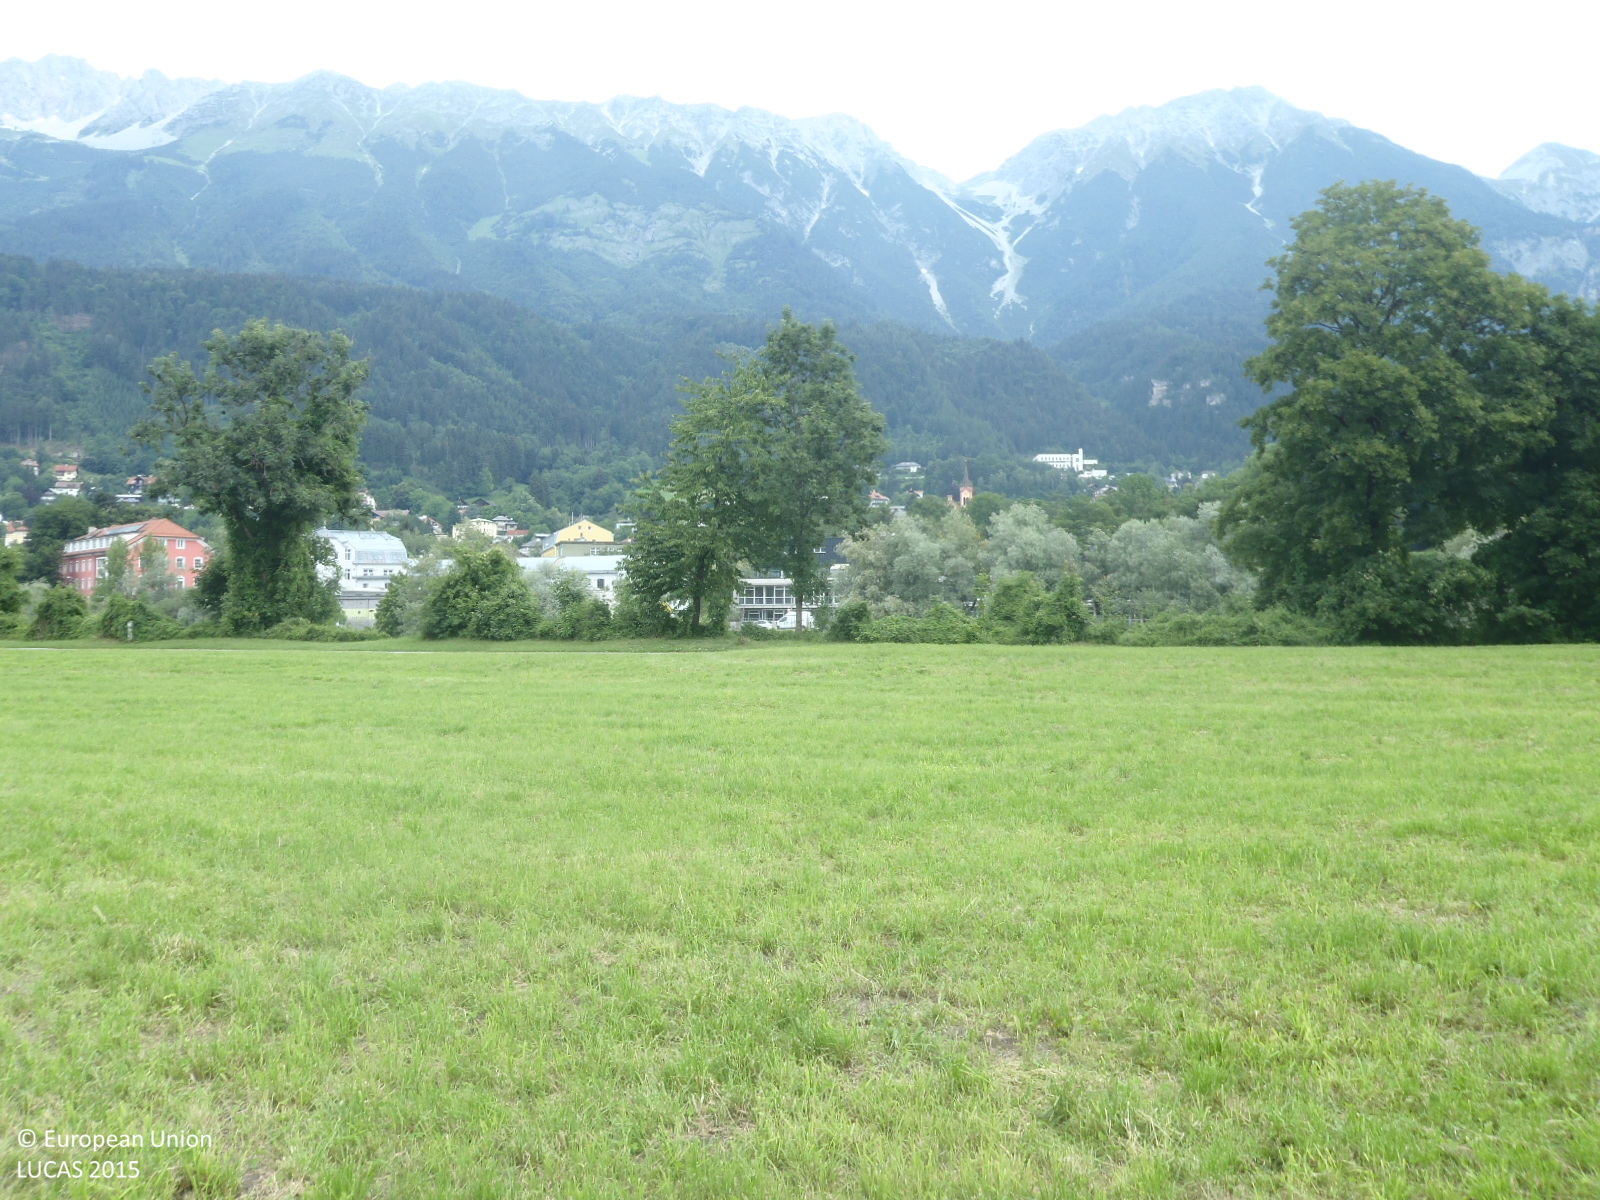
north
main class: Grassland
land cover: Grassland without tree/shrub cover
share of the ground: > 75 %
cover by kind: herbaceous plants 100 %
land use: Agriculture (excluding fallow land and kitchen gardens)
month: June
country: AT
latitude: 47.2784
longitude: 11.4132
